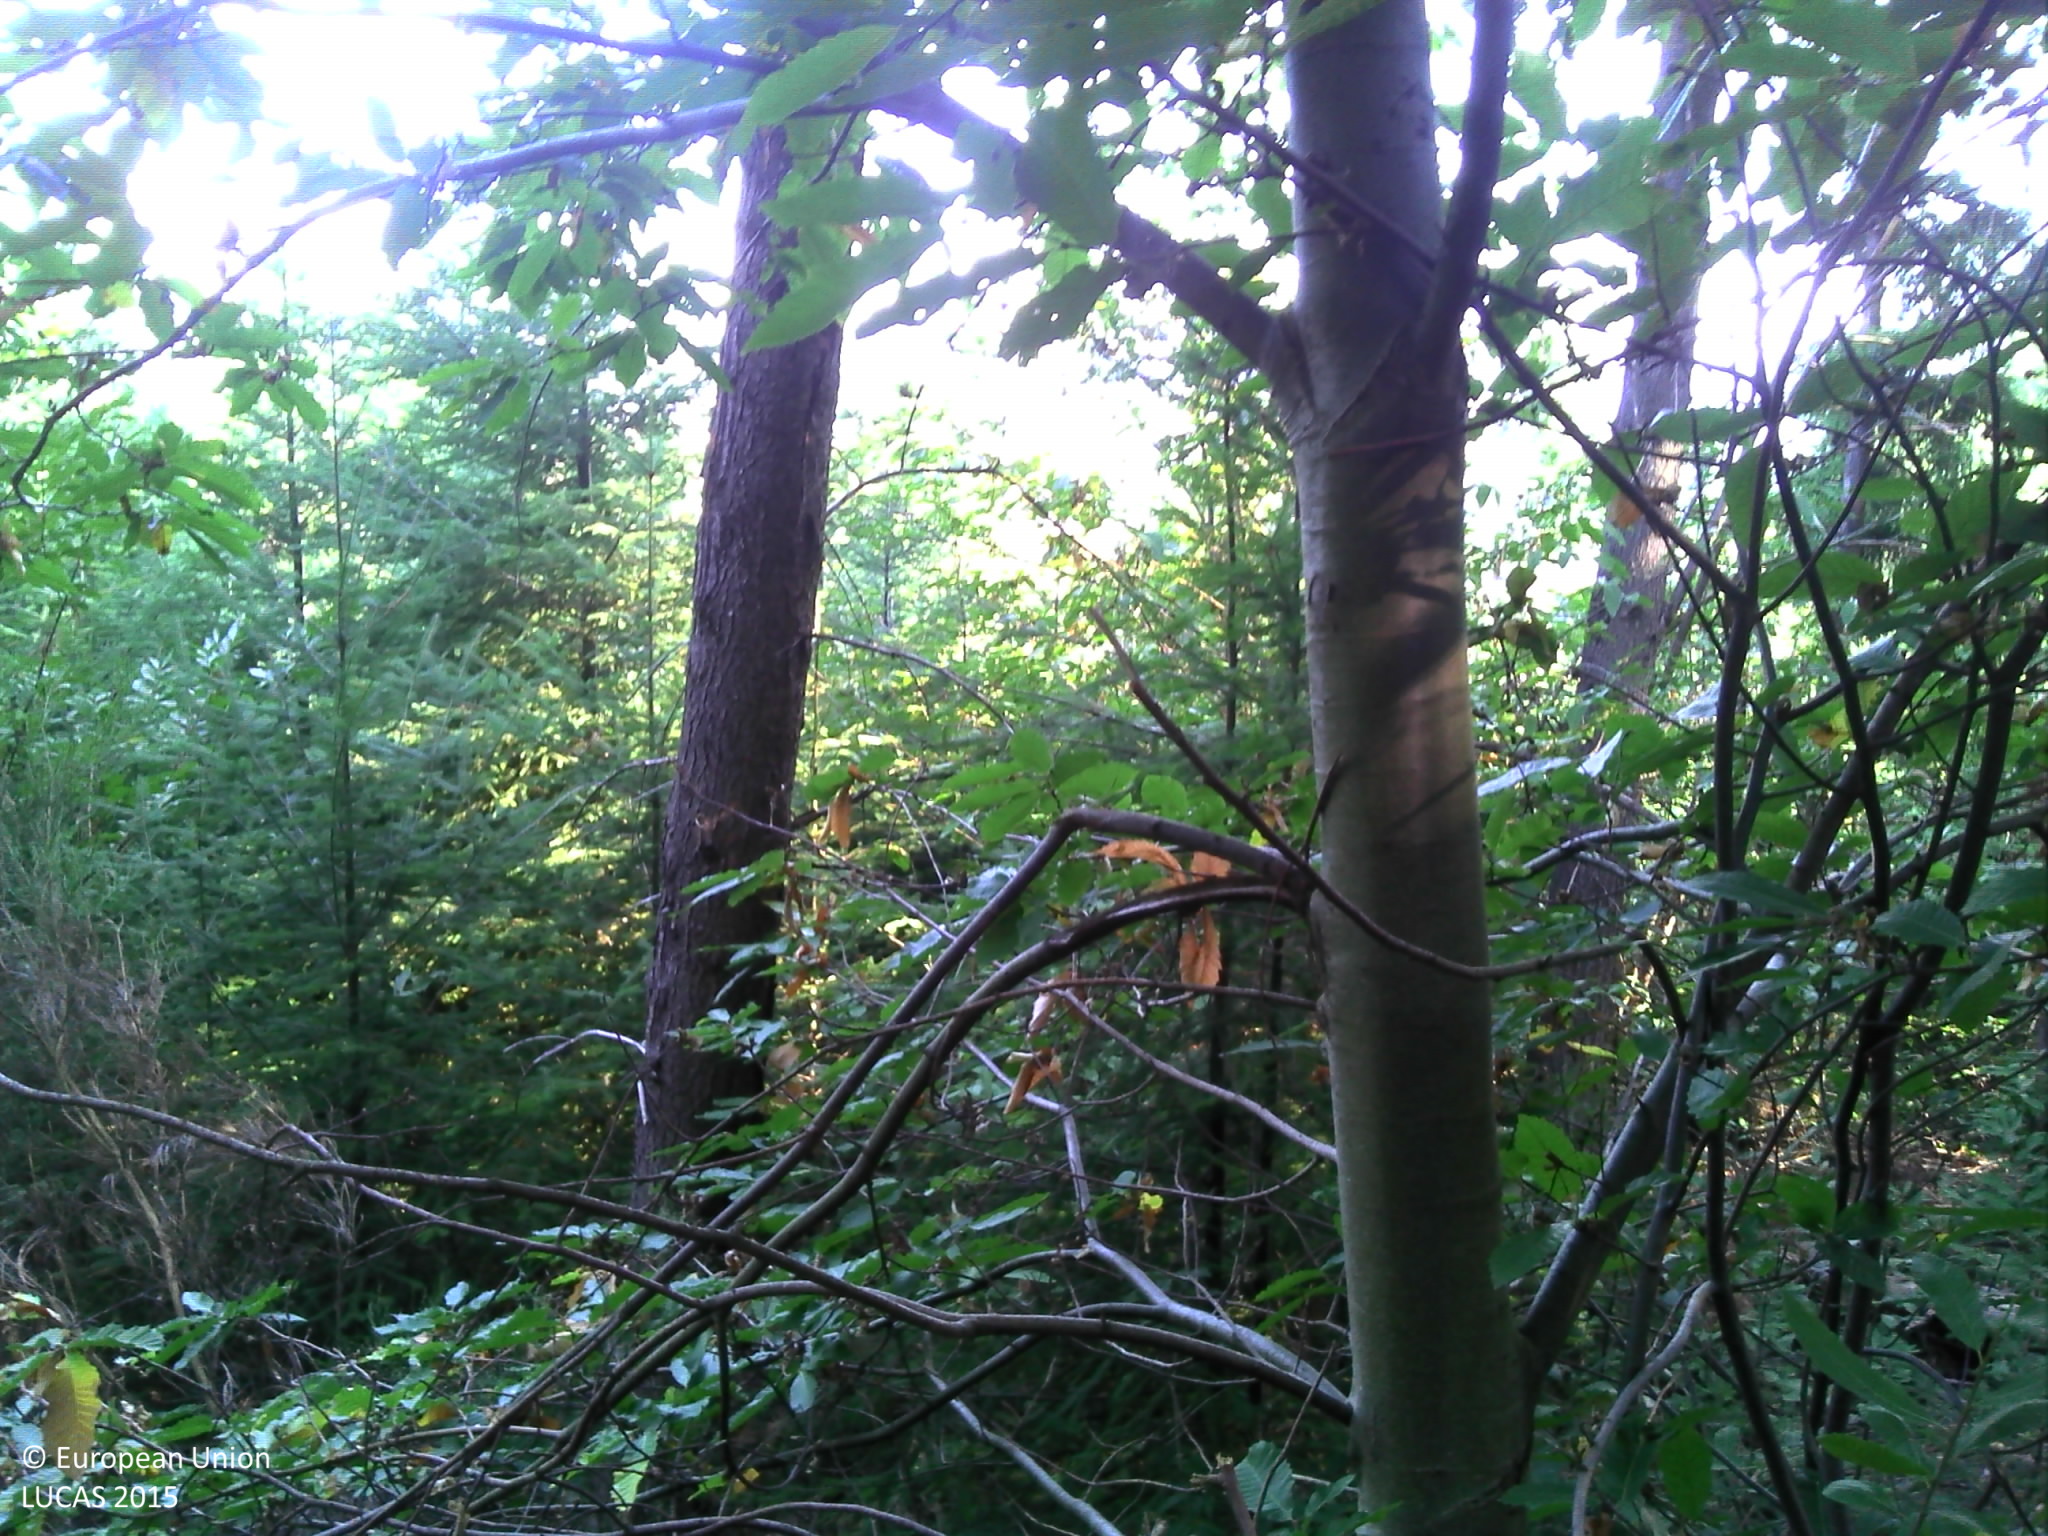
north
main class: Woodland
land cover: Spruce dominated mixed woodland
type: alpine coniferous forest
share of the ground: > 75 %
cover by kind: coniferous forest trees 50 %, broadleaved forest trees 25 %, herbaceous plants 25 %
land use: Forestry
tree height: > 5 m
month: August
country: FR
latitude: 45.0609
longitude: 4.6333
